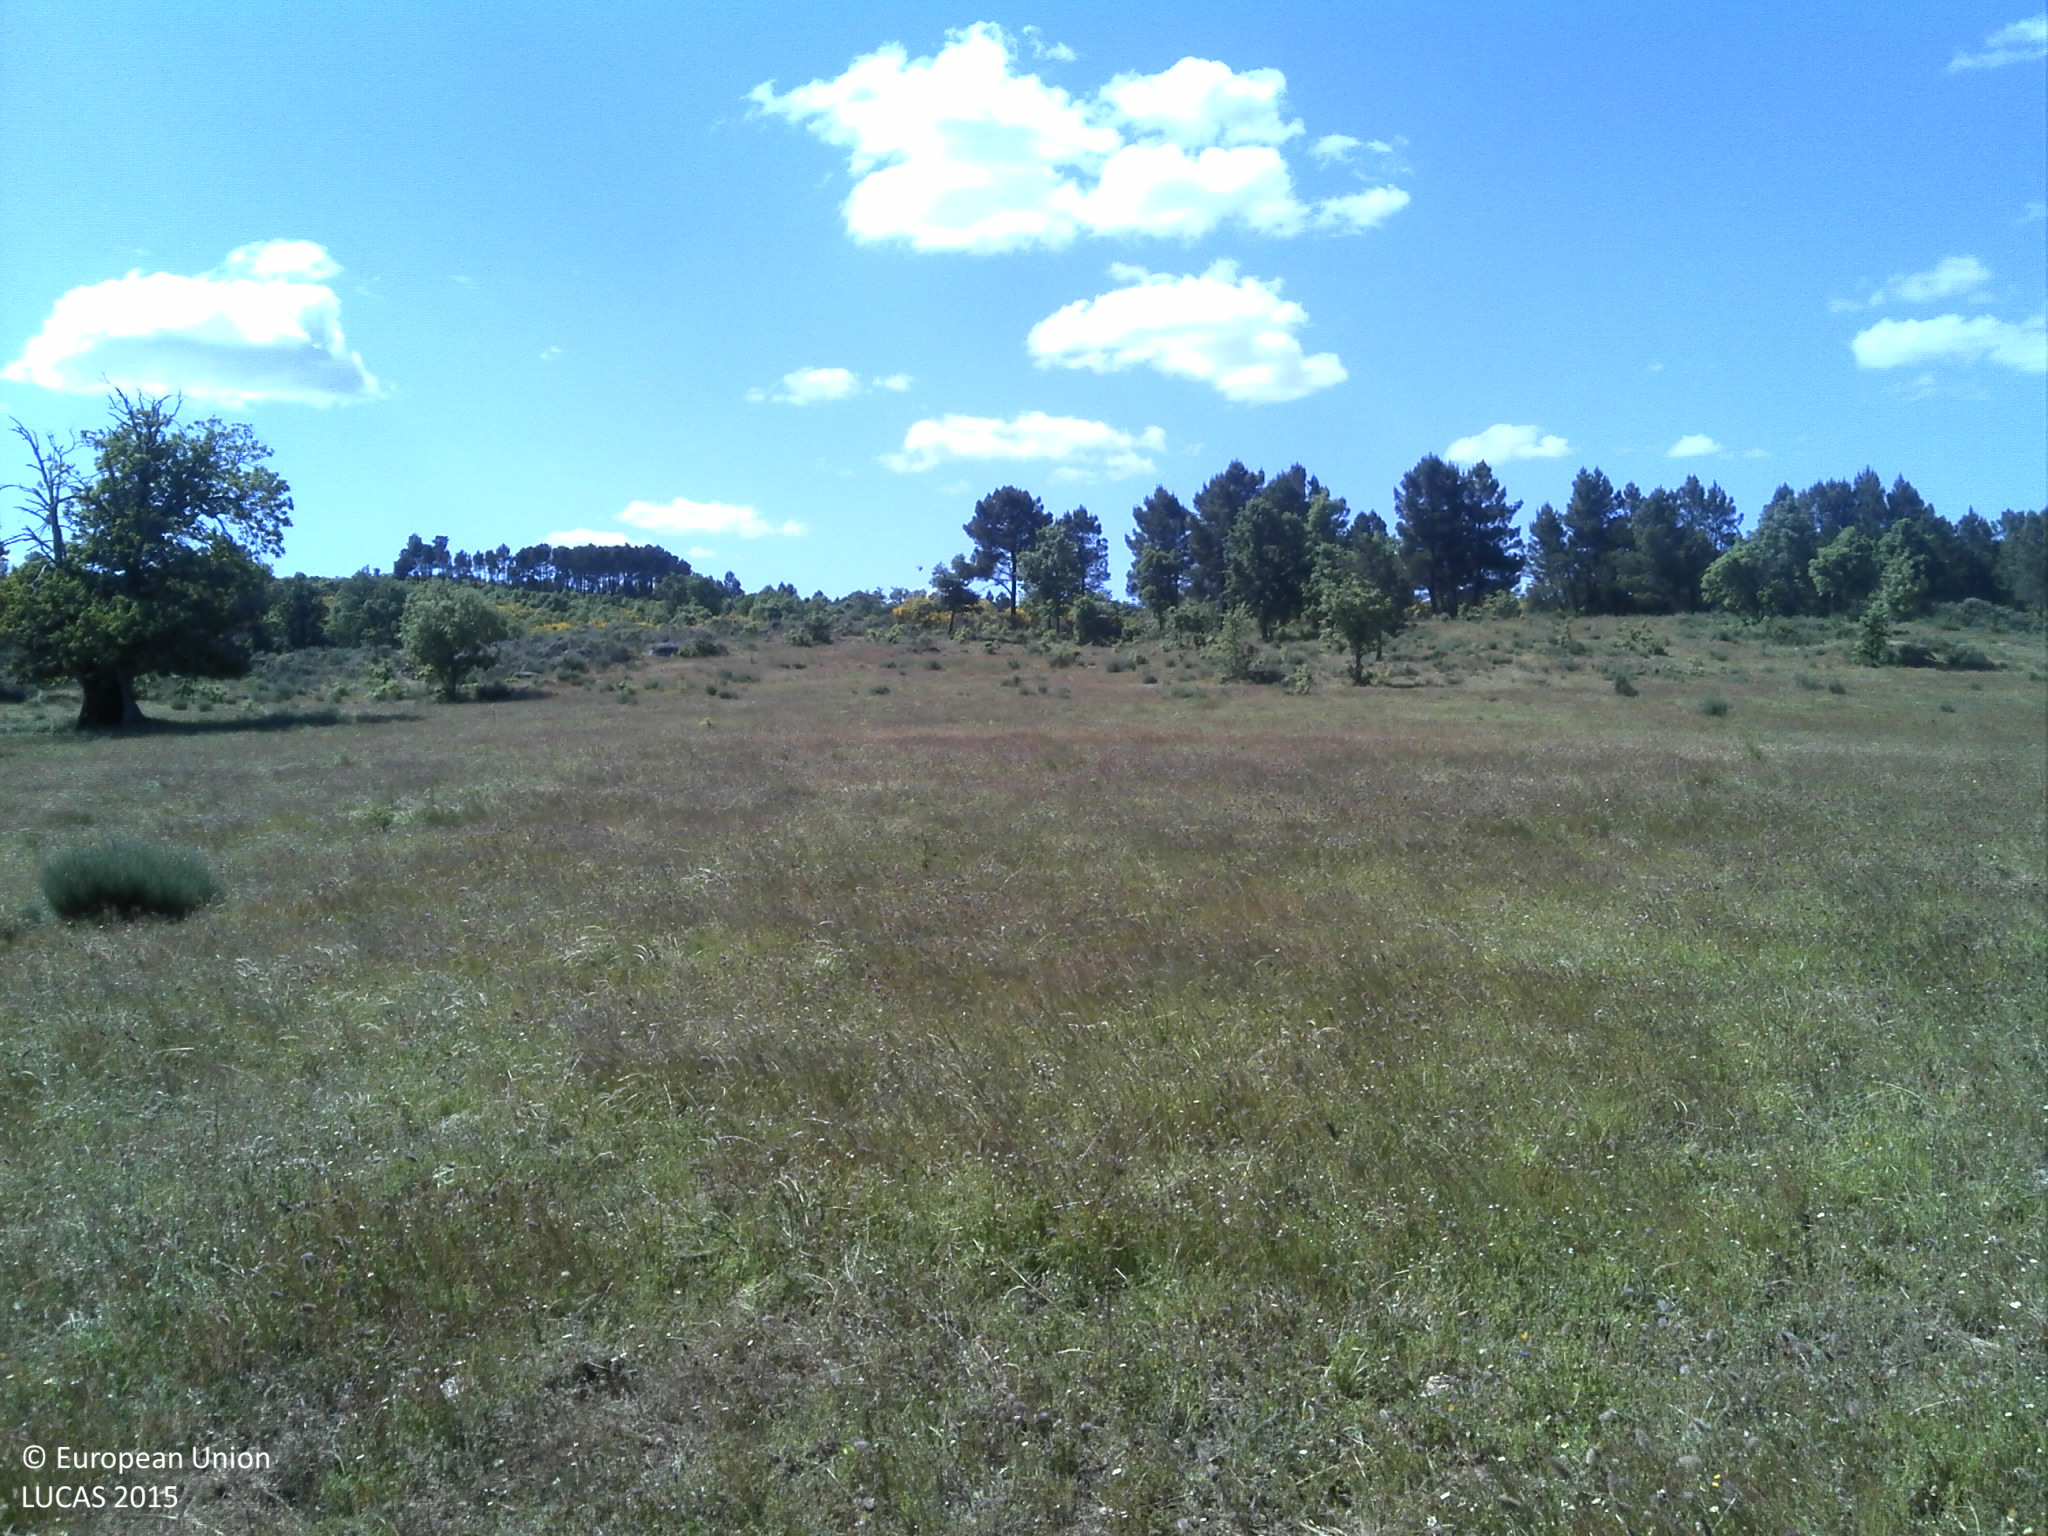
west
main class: Grassland
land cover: Grassland with sparse tree/shrub cover
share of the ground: 50 - 75 %
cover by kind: herbaceous plants 65 %, consolidated bare surface 20 %, broadleaved forest trees 5 %
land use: Agriculture (excluding fallow land and kitchen gardens)
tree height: < 5 m
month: May
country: PT
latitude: 40.4879
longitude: -7.1982
